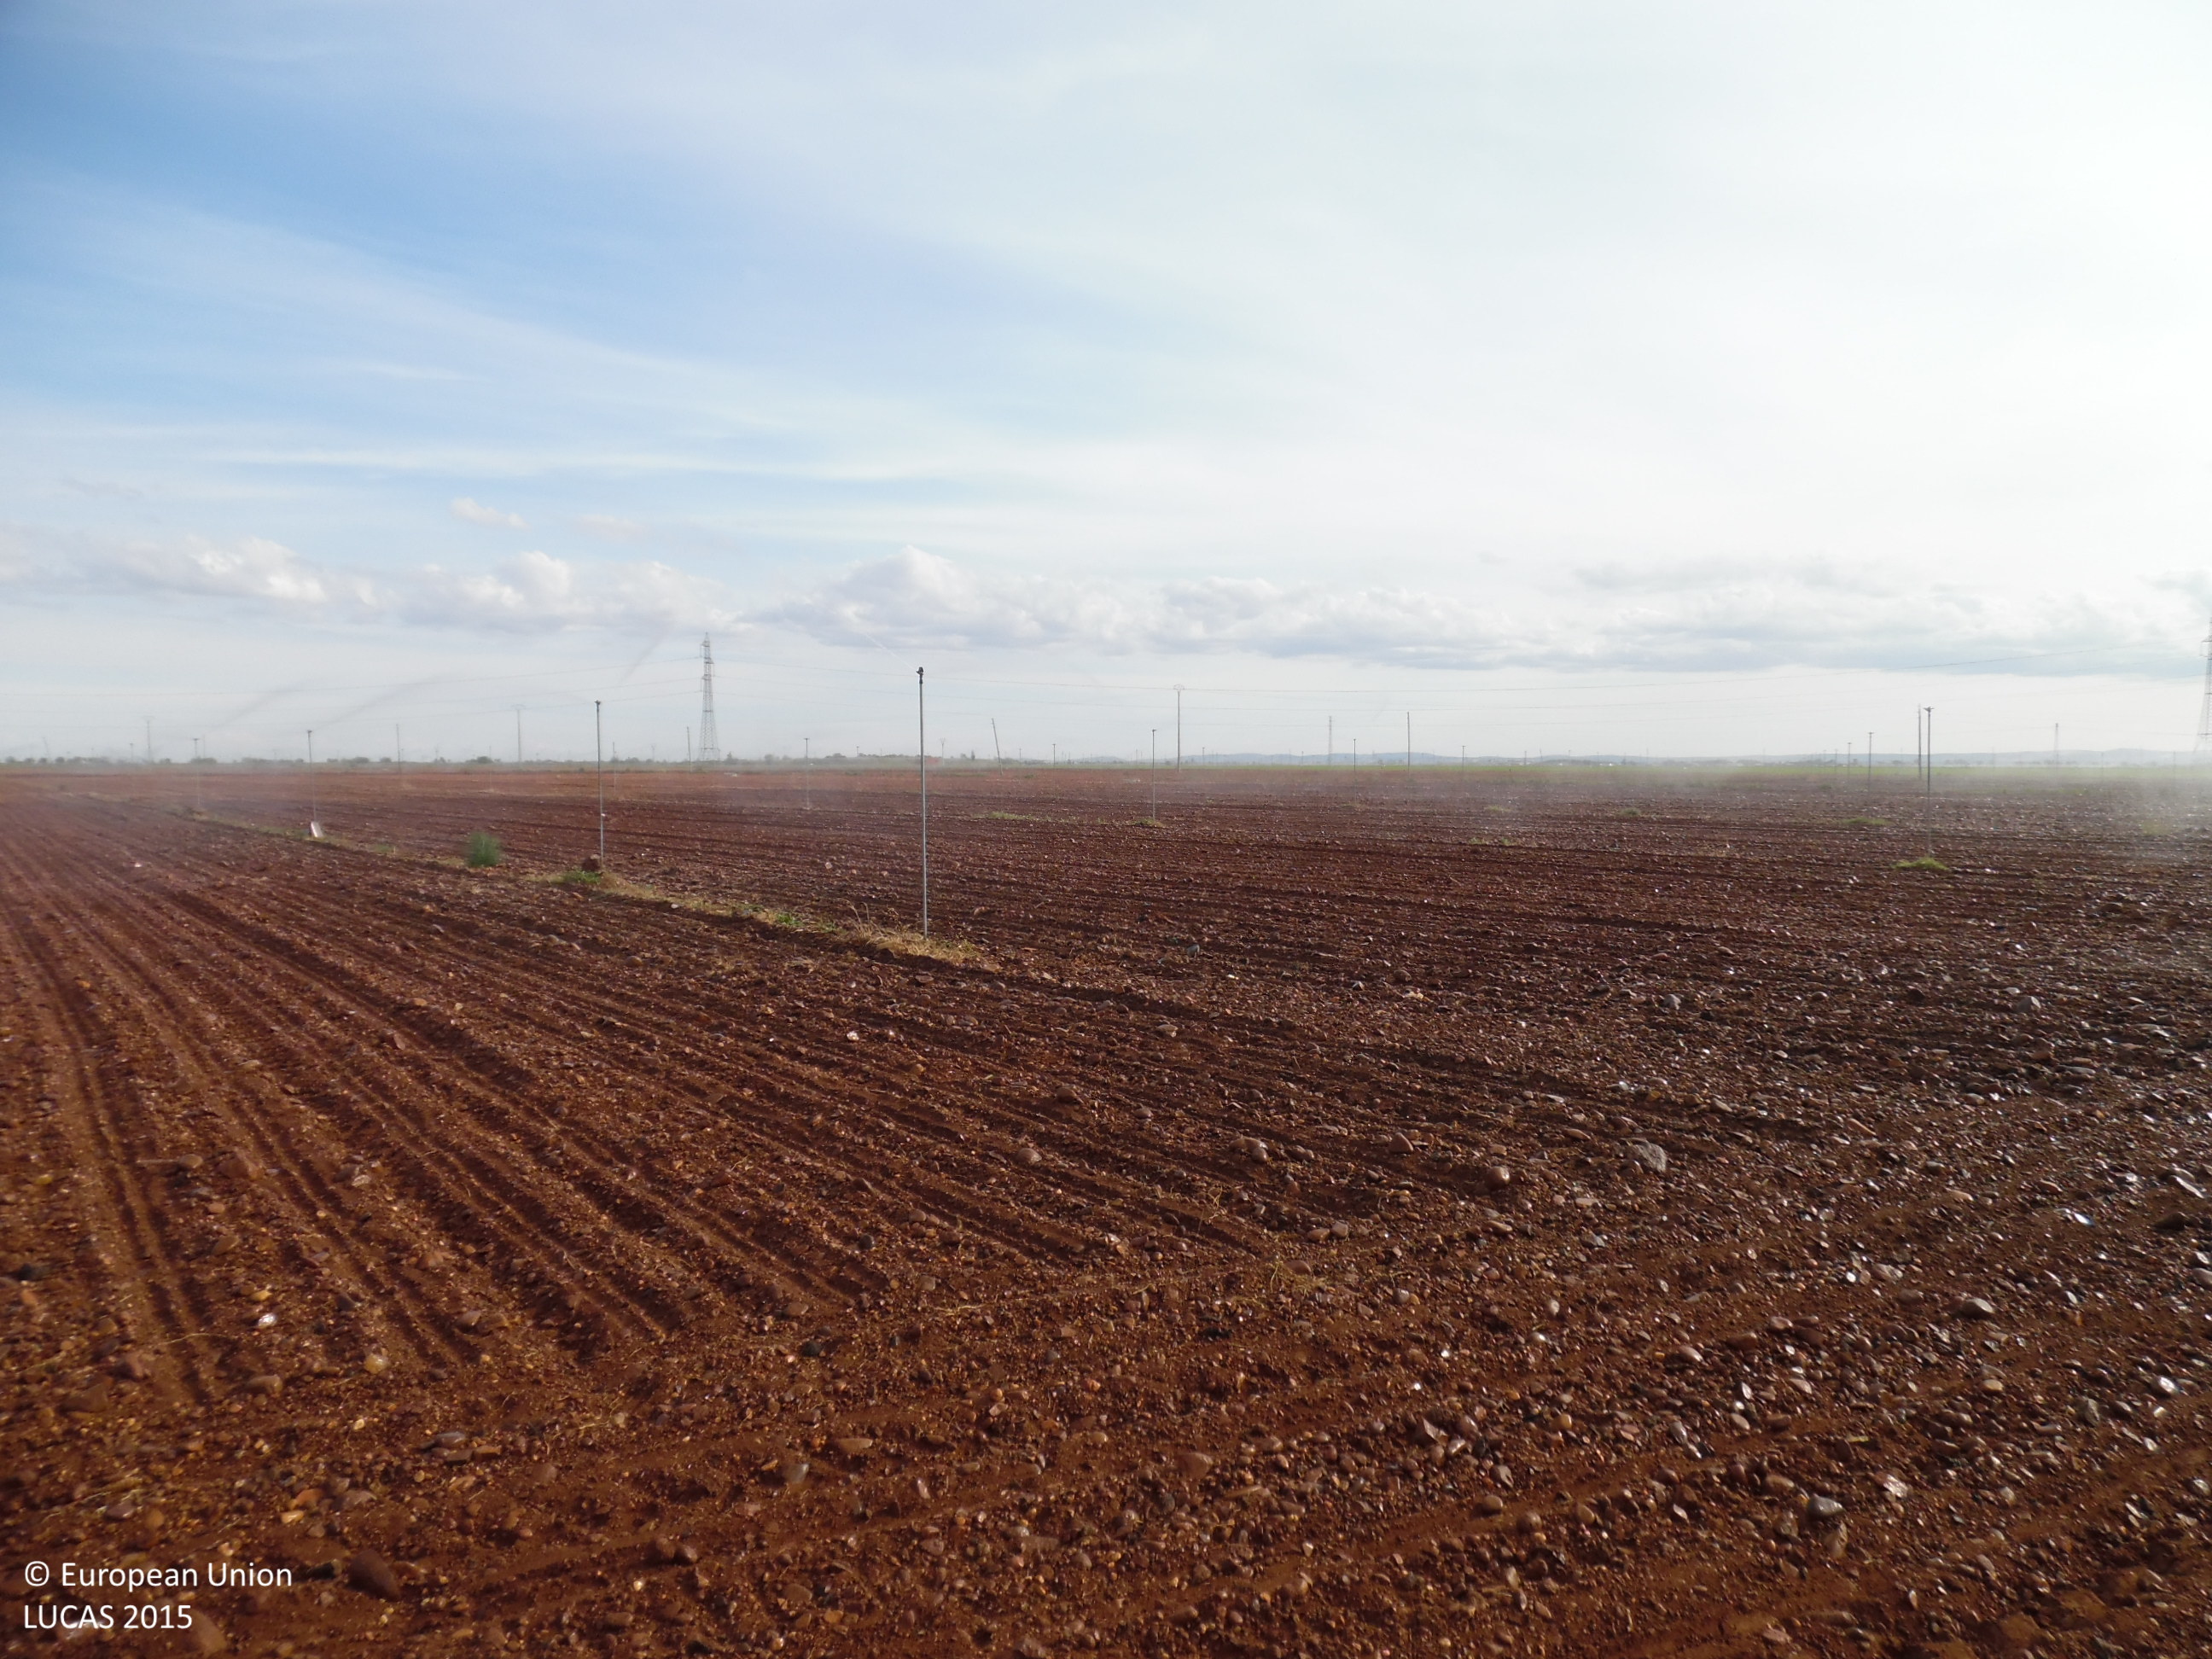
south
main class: Cropland
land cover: Maize
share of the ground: < 10 %
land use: Agriculture (excluding fallow land and kitchen gardens)
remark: Temporary flooded
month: June
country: ES
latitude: 42.3362
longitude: -5.7171
